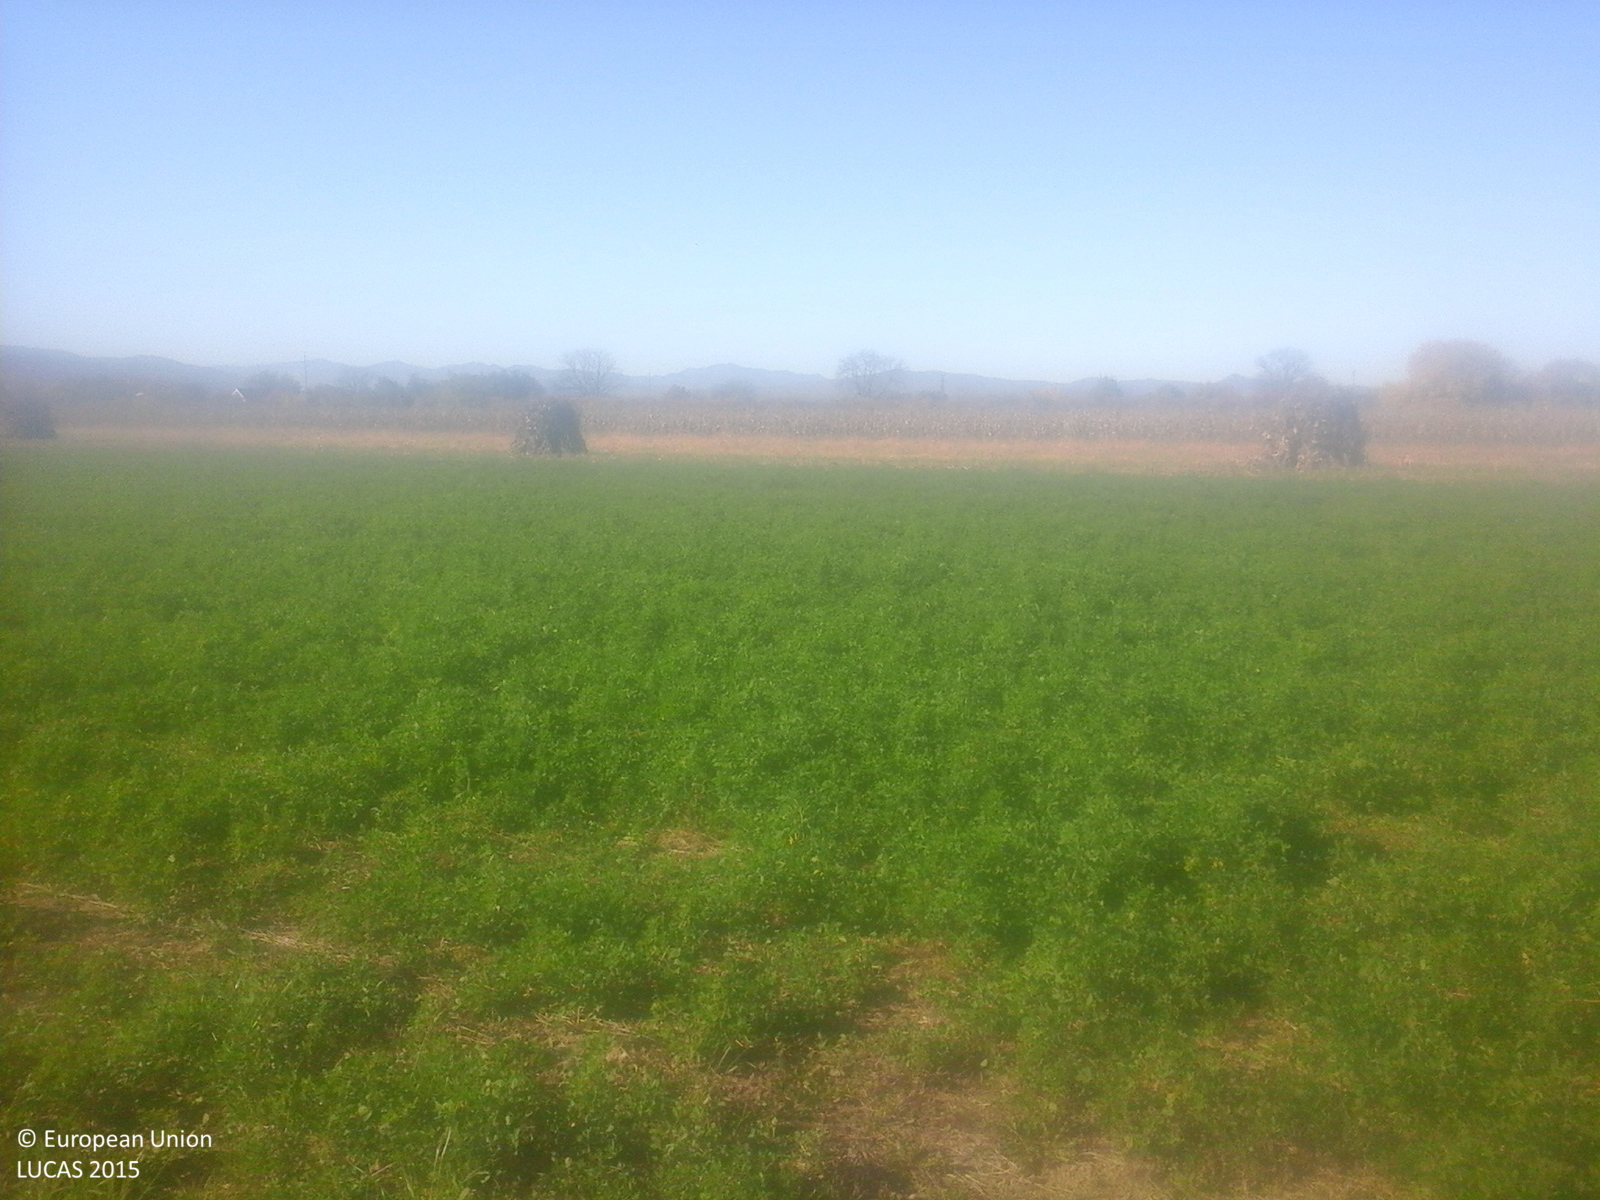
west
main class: Cropland
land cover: Lucerne
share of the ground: > 75 %
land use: Agriculture (excluding fallow land and kitchen gardens)
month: October
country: RO
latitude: 45.9205
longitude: 26.9687
